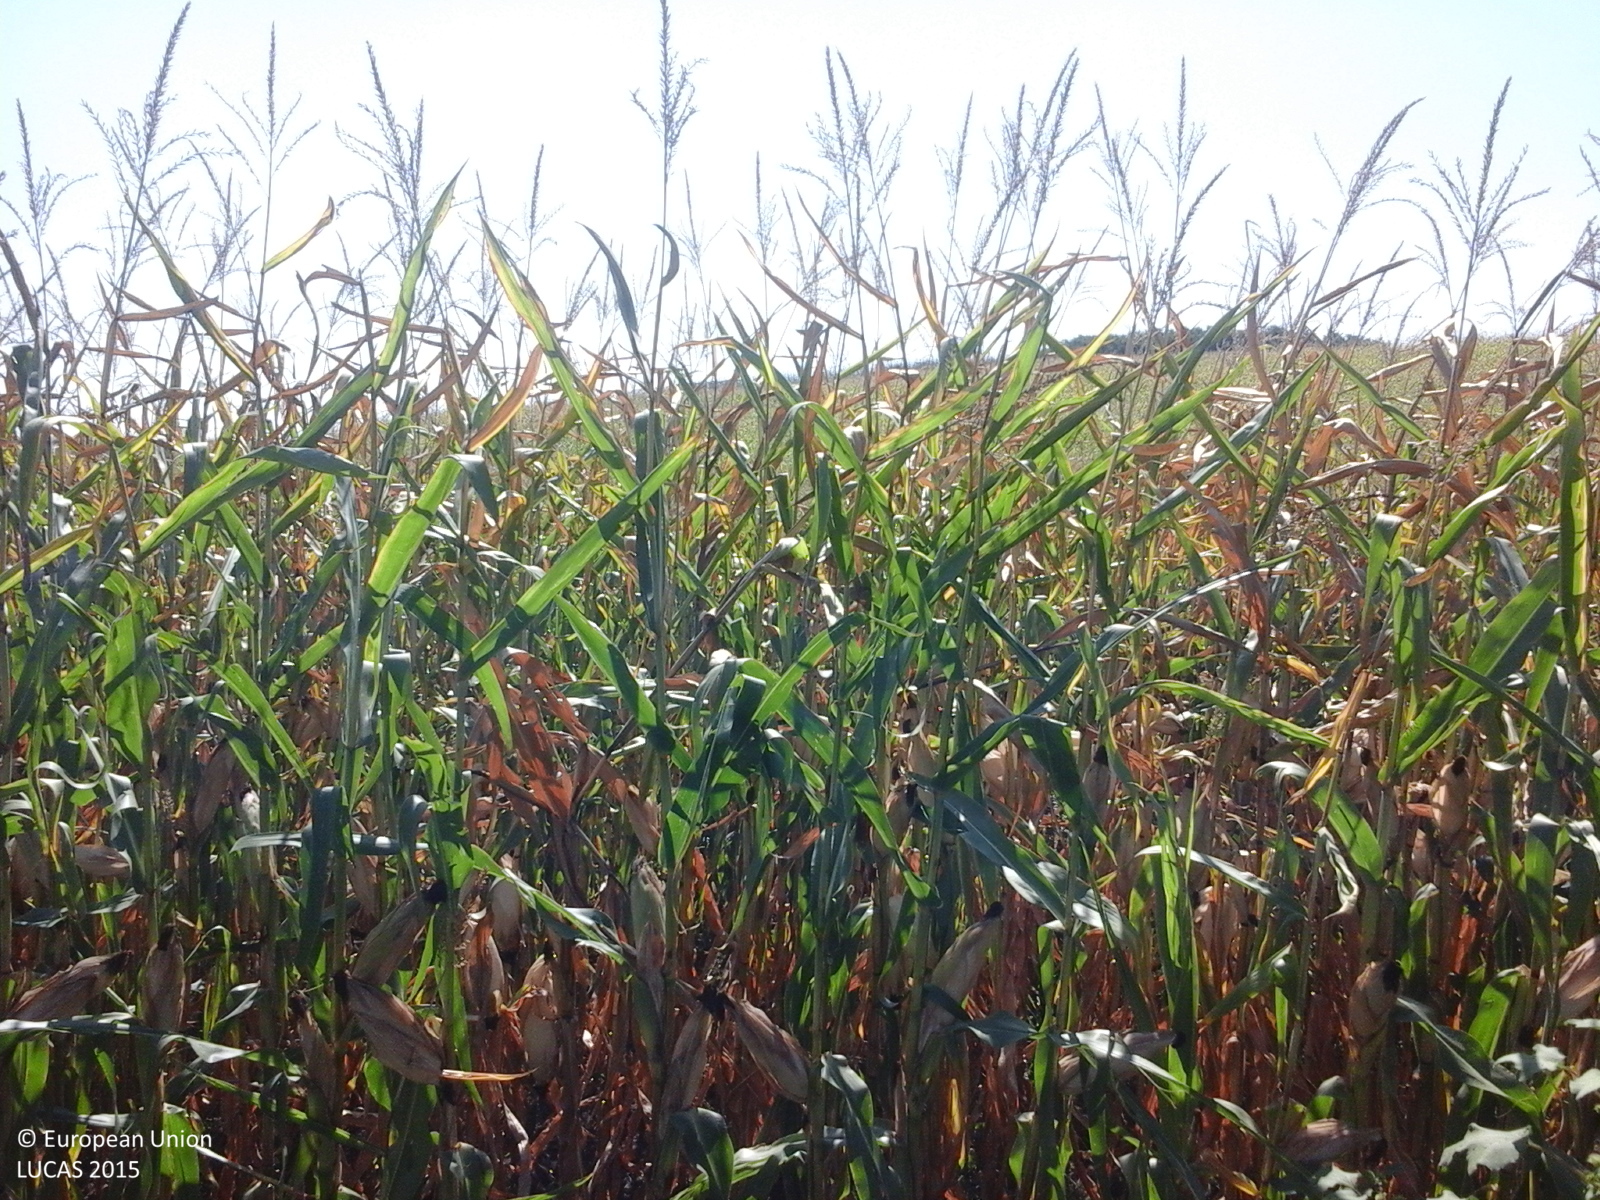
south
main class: Cropland
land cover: Maize
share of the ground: > 75 %
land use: Agriculture (excluding fallow land and kitchen gardens)
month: September
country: RO
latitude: 46.7006
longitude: 24.4338
